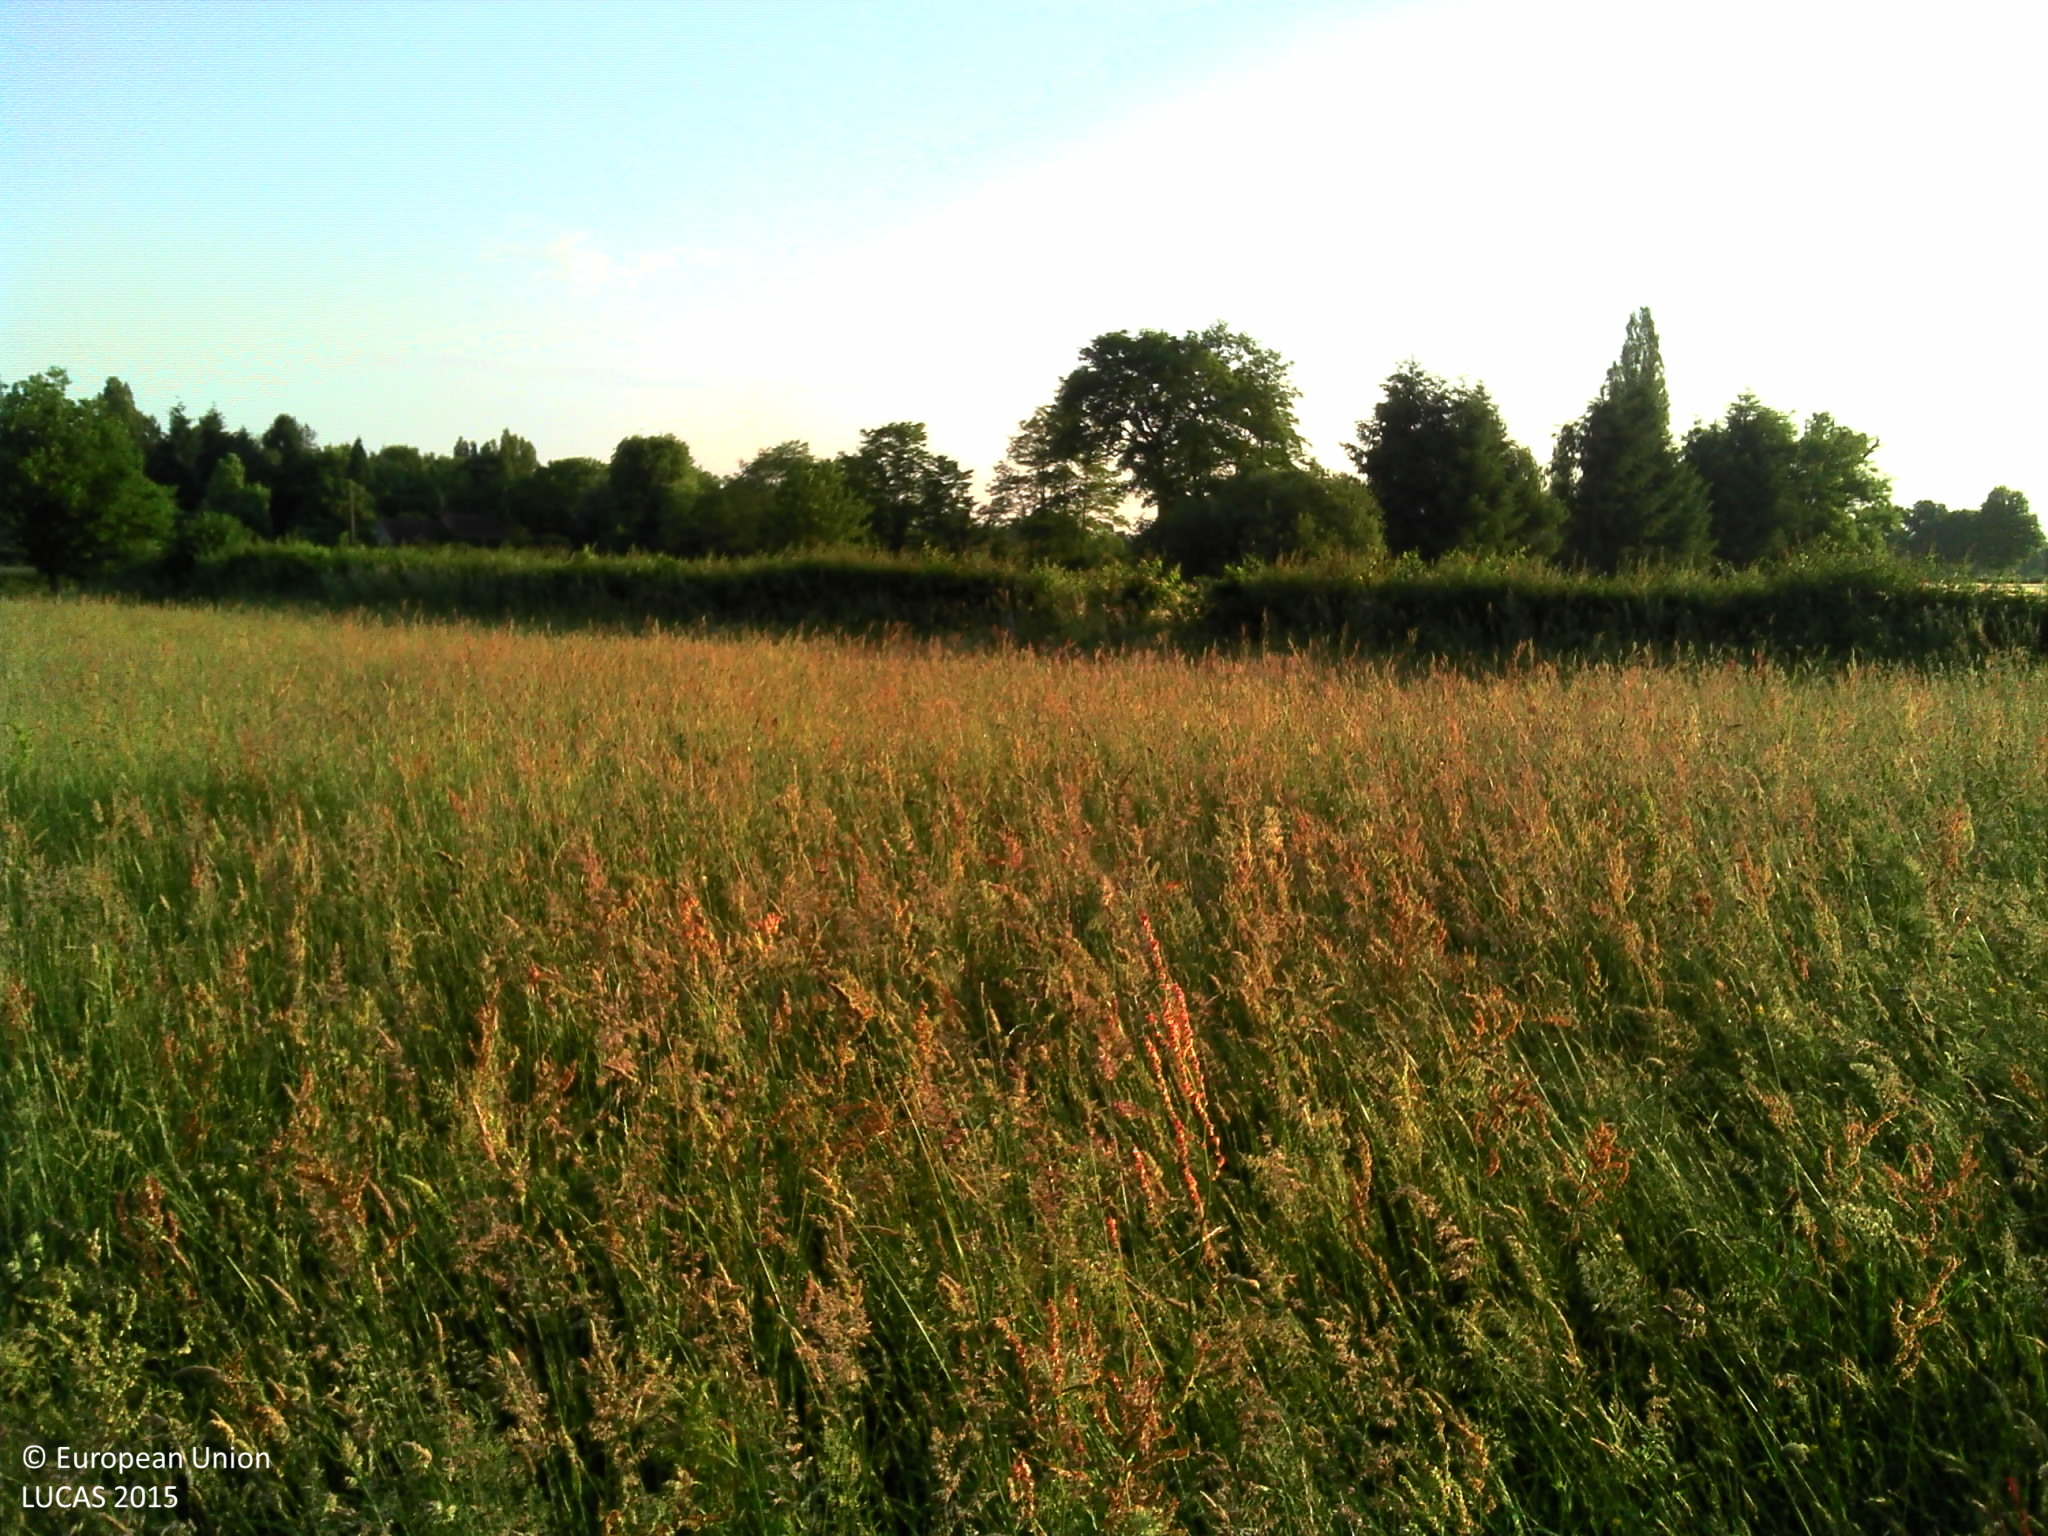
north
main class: Grassland
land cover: Grassland without tree/shrub cover
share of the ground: > 75 %
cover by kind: herbaceous plants 100 %
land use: Agriculture (excluding fallow land and kitchen gardens)
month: June
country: FR
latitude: 46.8042
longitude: 2.9332
